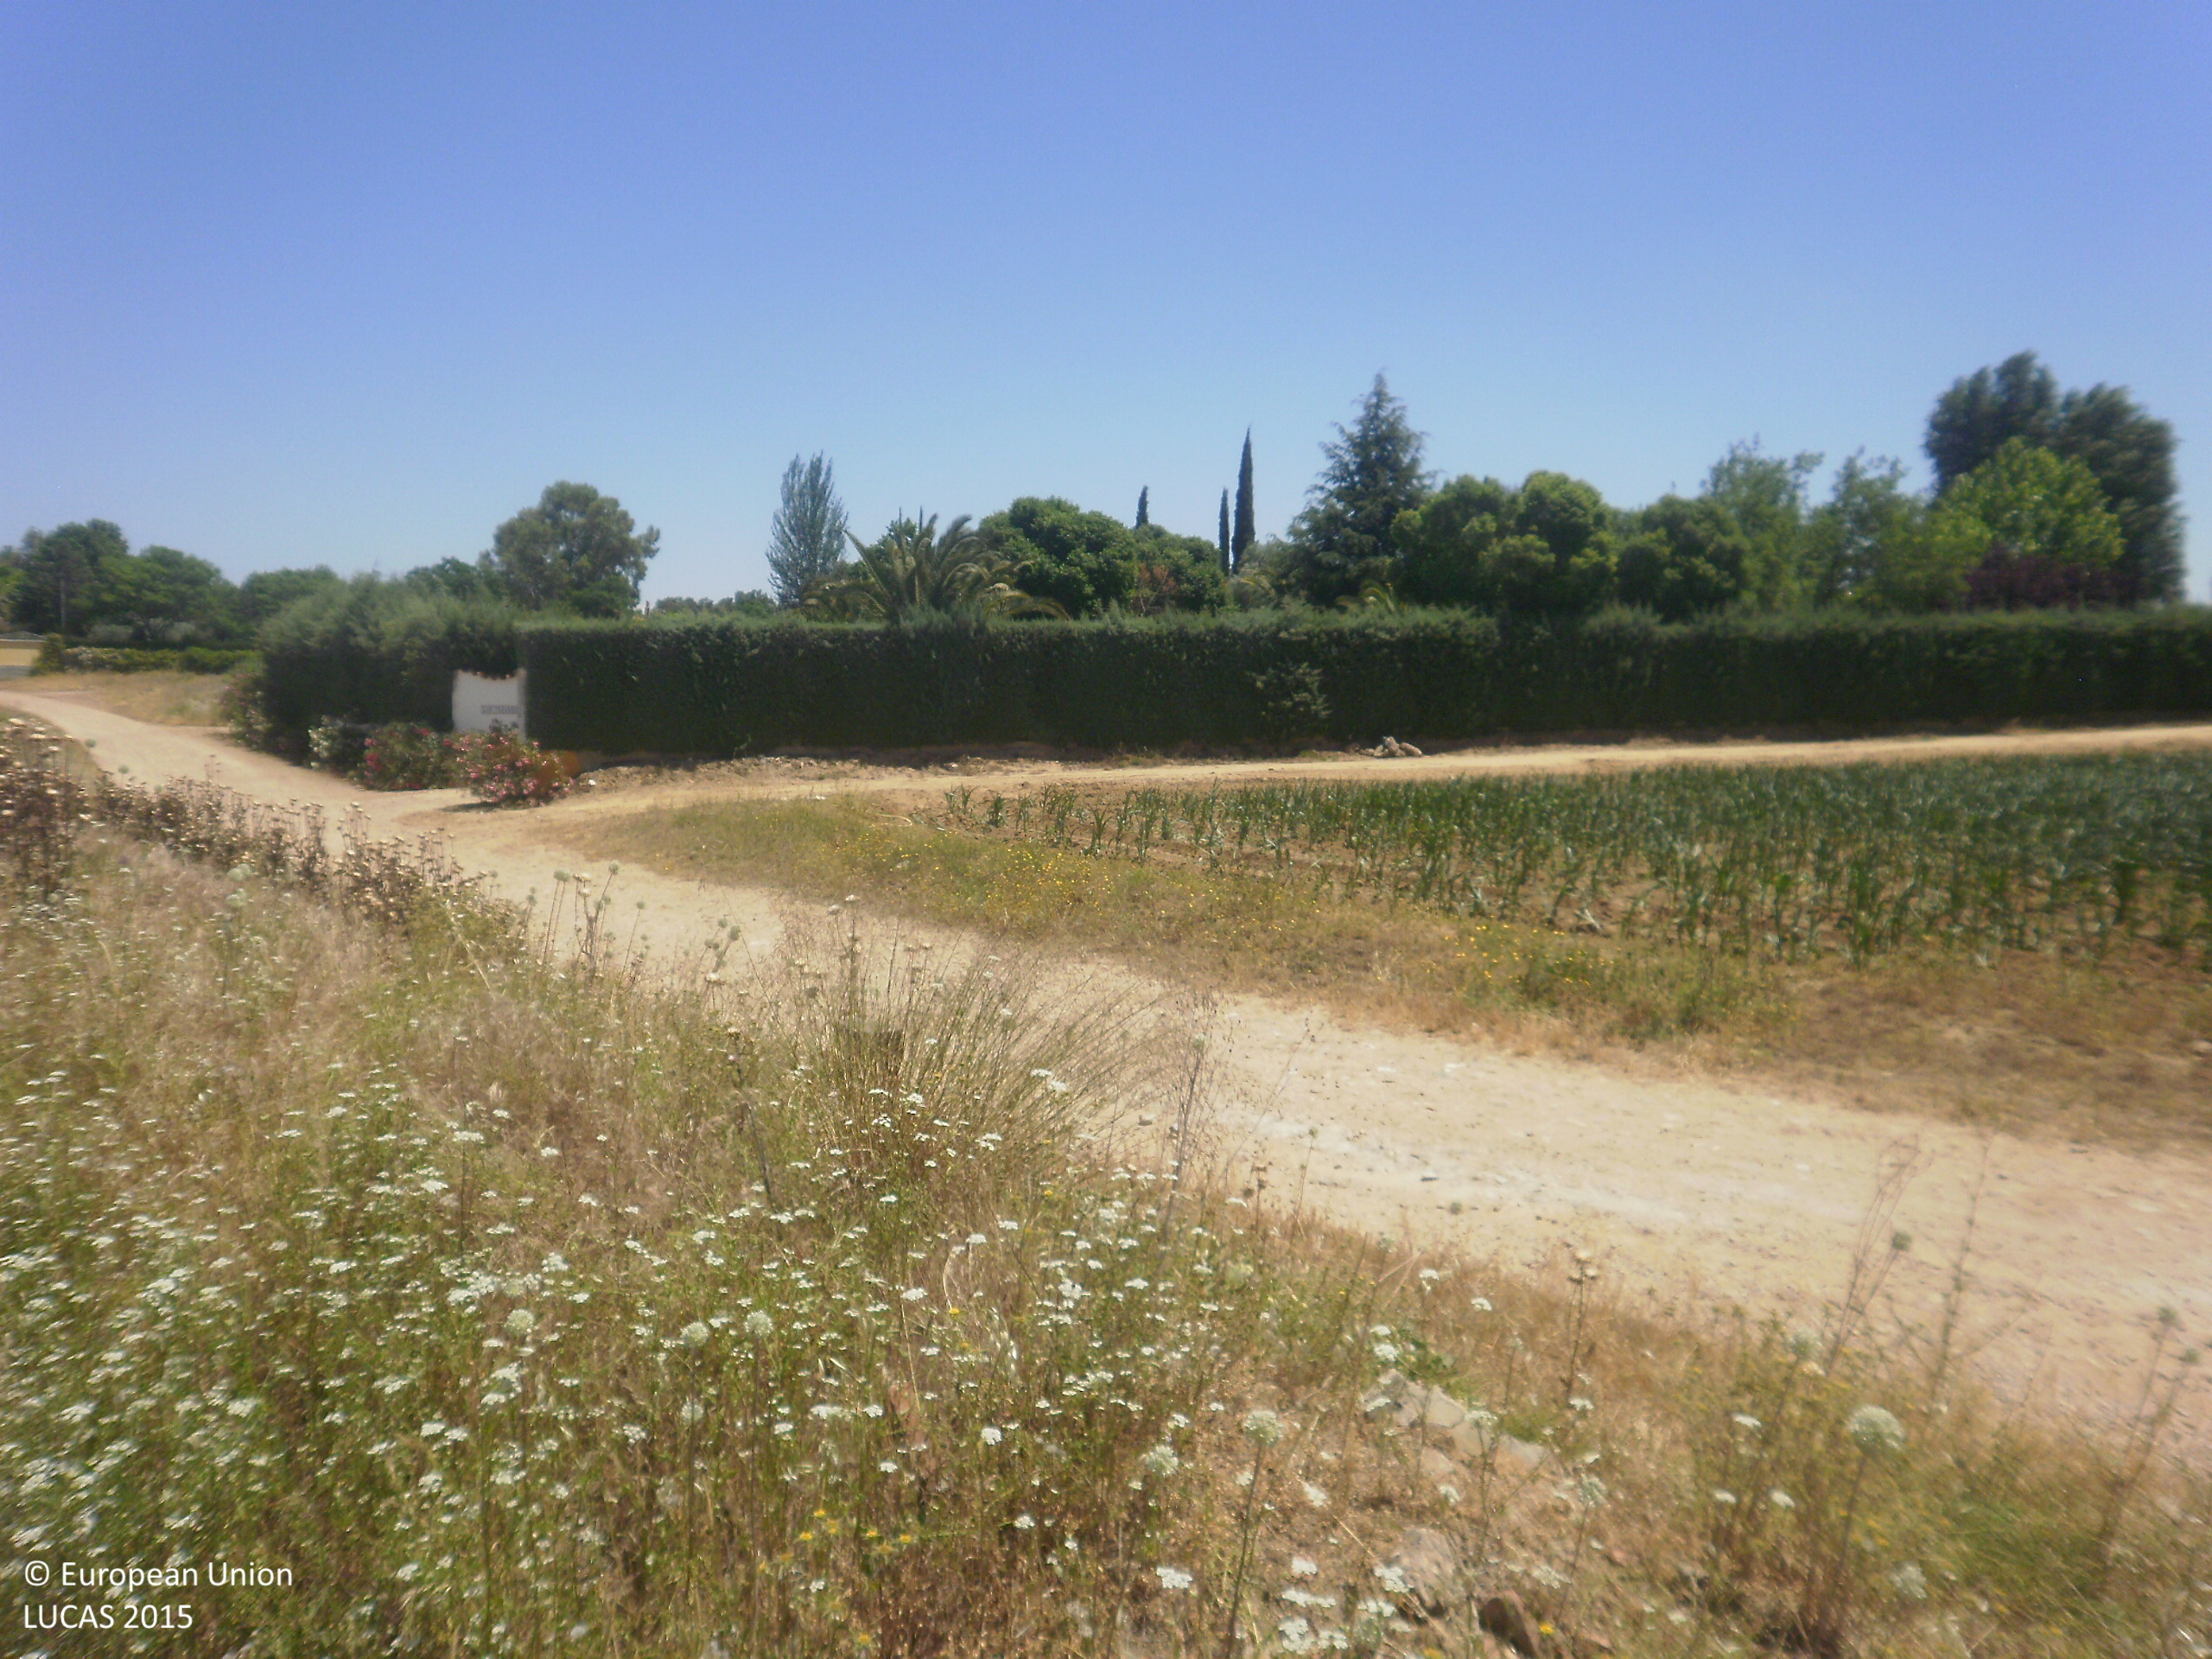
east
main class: Shrubland
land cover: Shrubland without tree cover
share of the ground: 25 - 50 %
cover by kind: herbaceous plants 70 %, shrubs 30 %
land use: Mining and quarrying
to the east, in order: Shrubland without tree cover; Grassland with sparse tree/shrub cover; Inland fresh water bodies; Shrubland without tree cover; Inland fresh water bodies; Grassland without tree/shrub cover; Tracks; Grassland with sparse tree/shrub cover
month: May
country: ES
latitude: 39.0163
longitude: -5.7908
